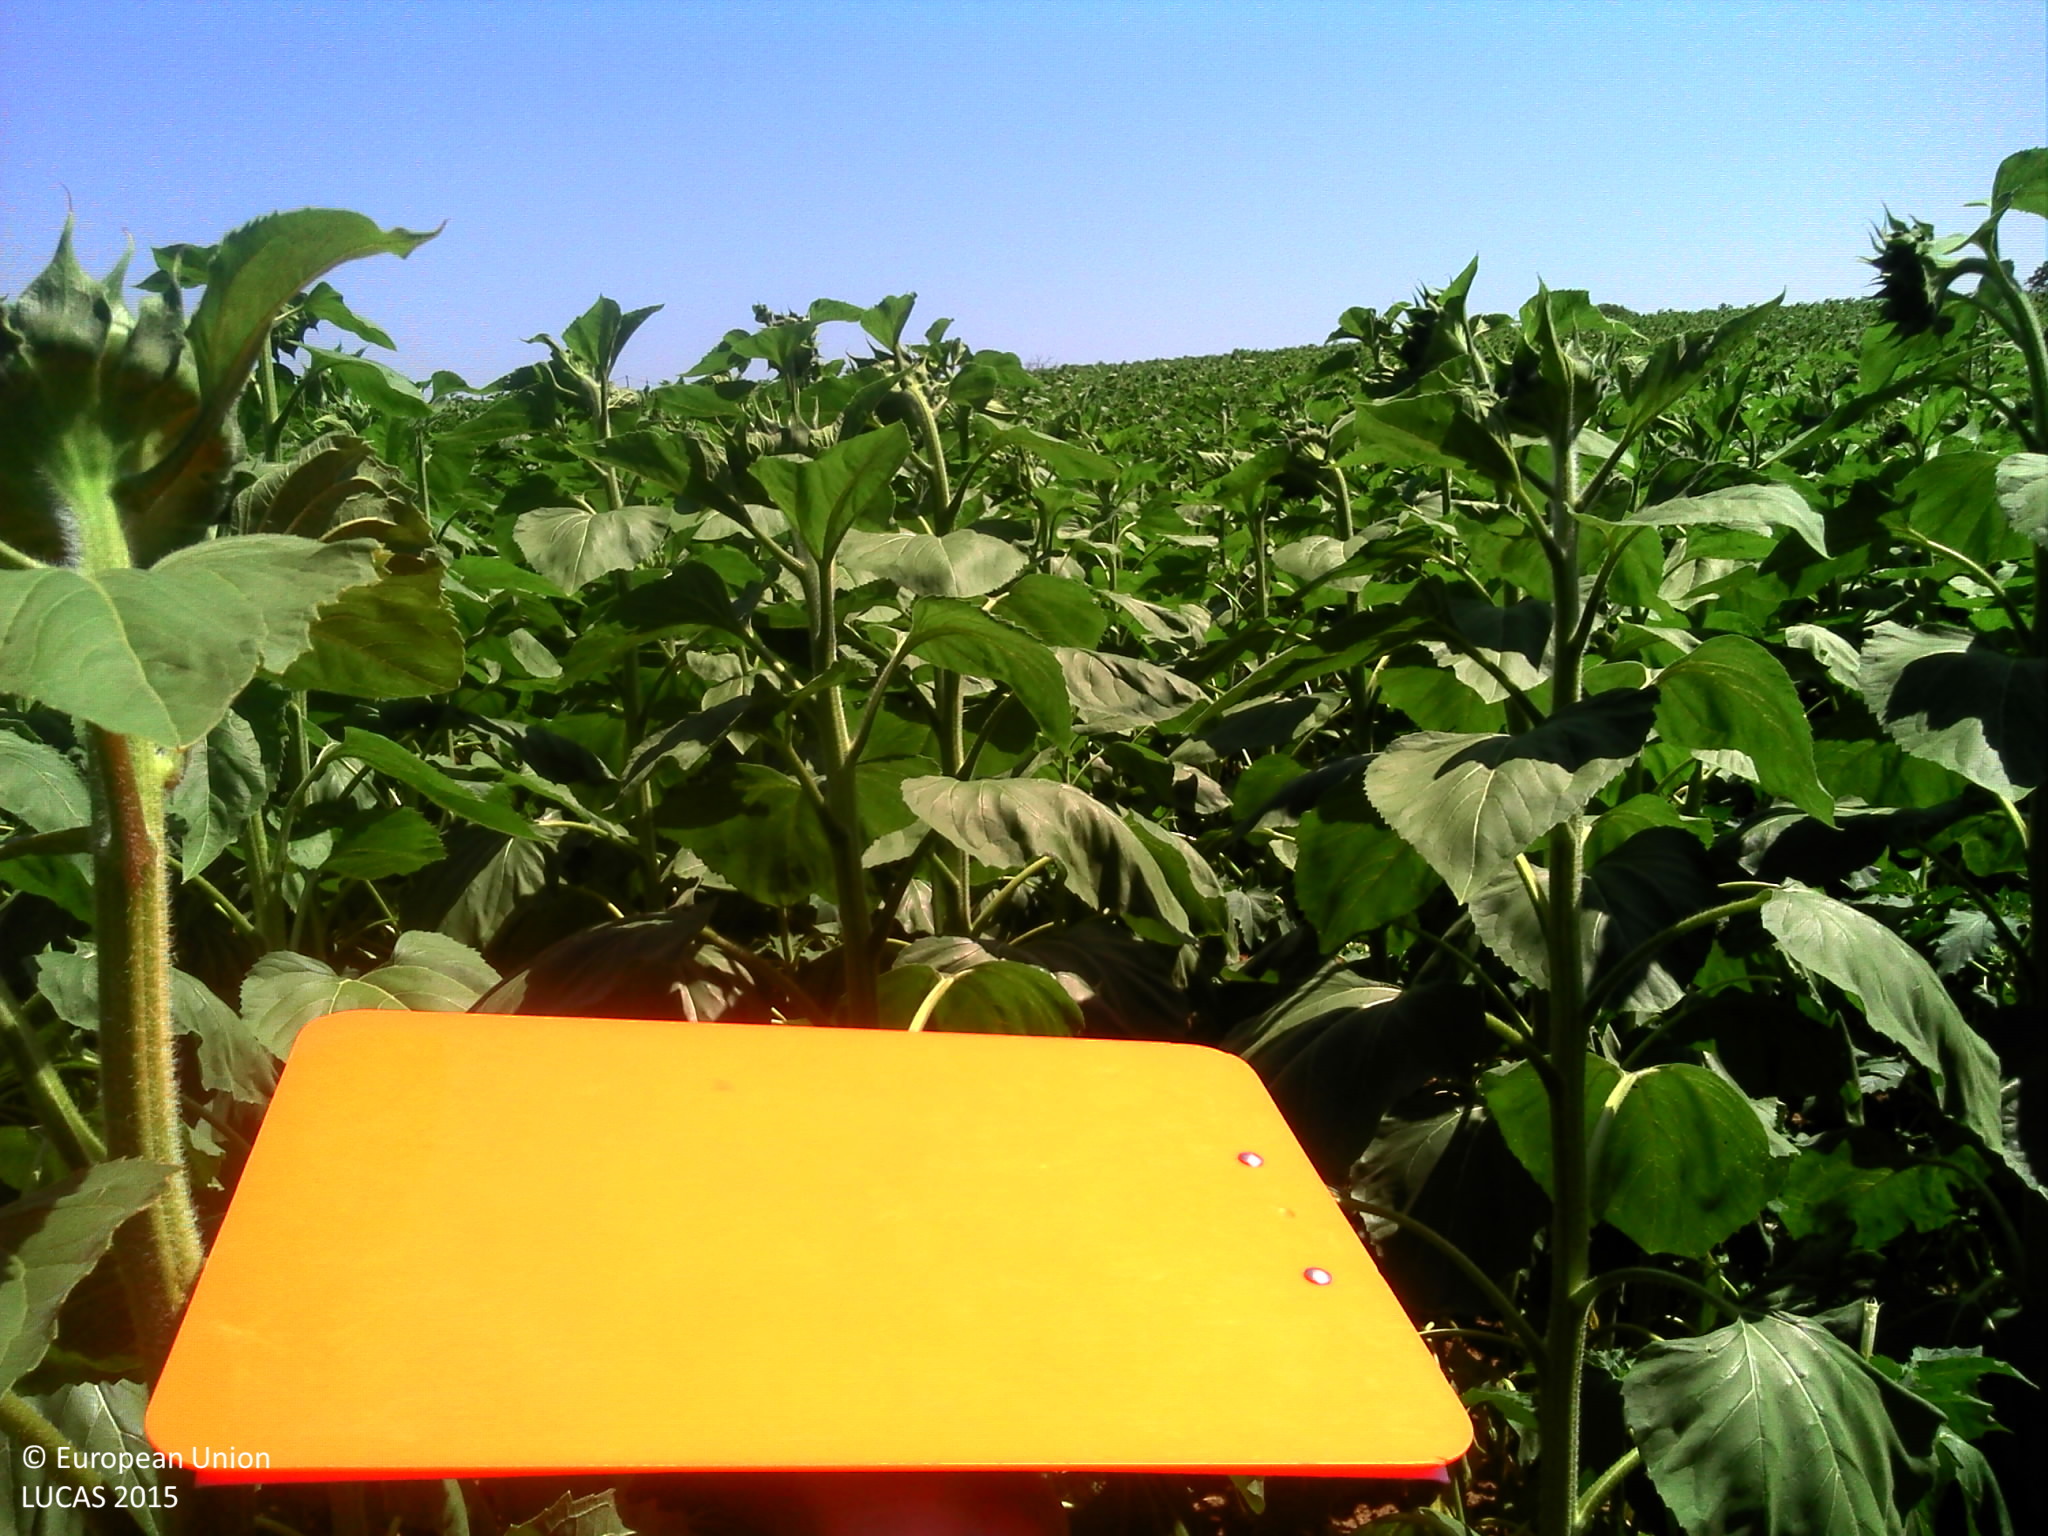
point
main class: Cropland
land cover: Sunflower
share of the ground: > 75 %
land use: Agriculture (excluding fallow land and kitchen gardens)
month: June
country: FR
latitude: 45.5591
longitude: -0.6954
